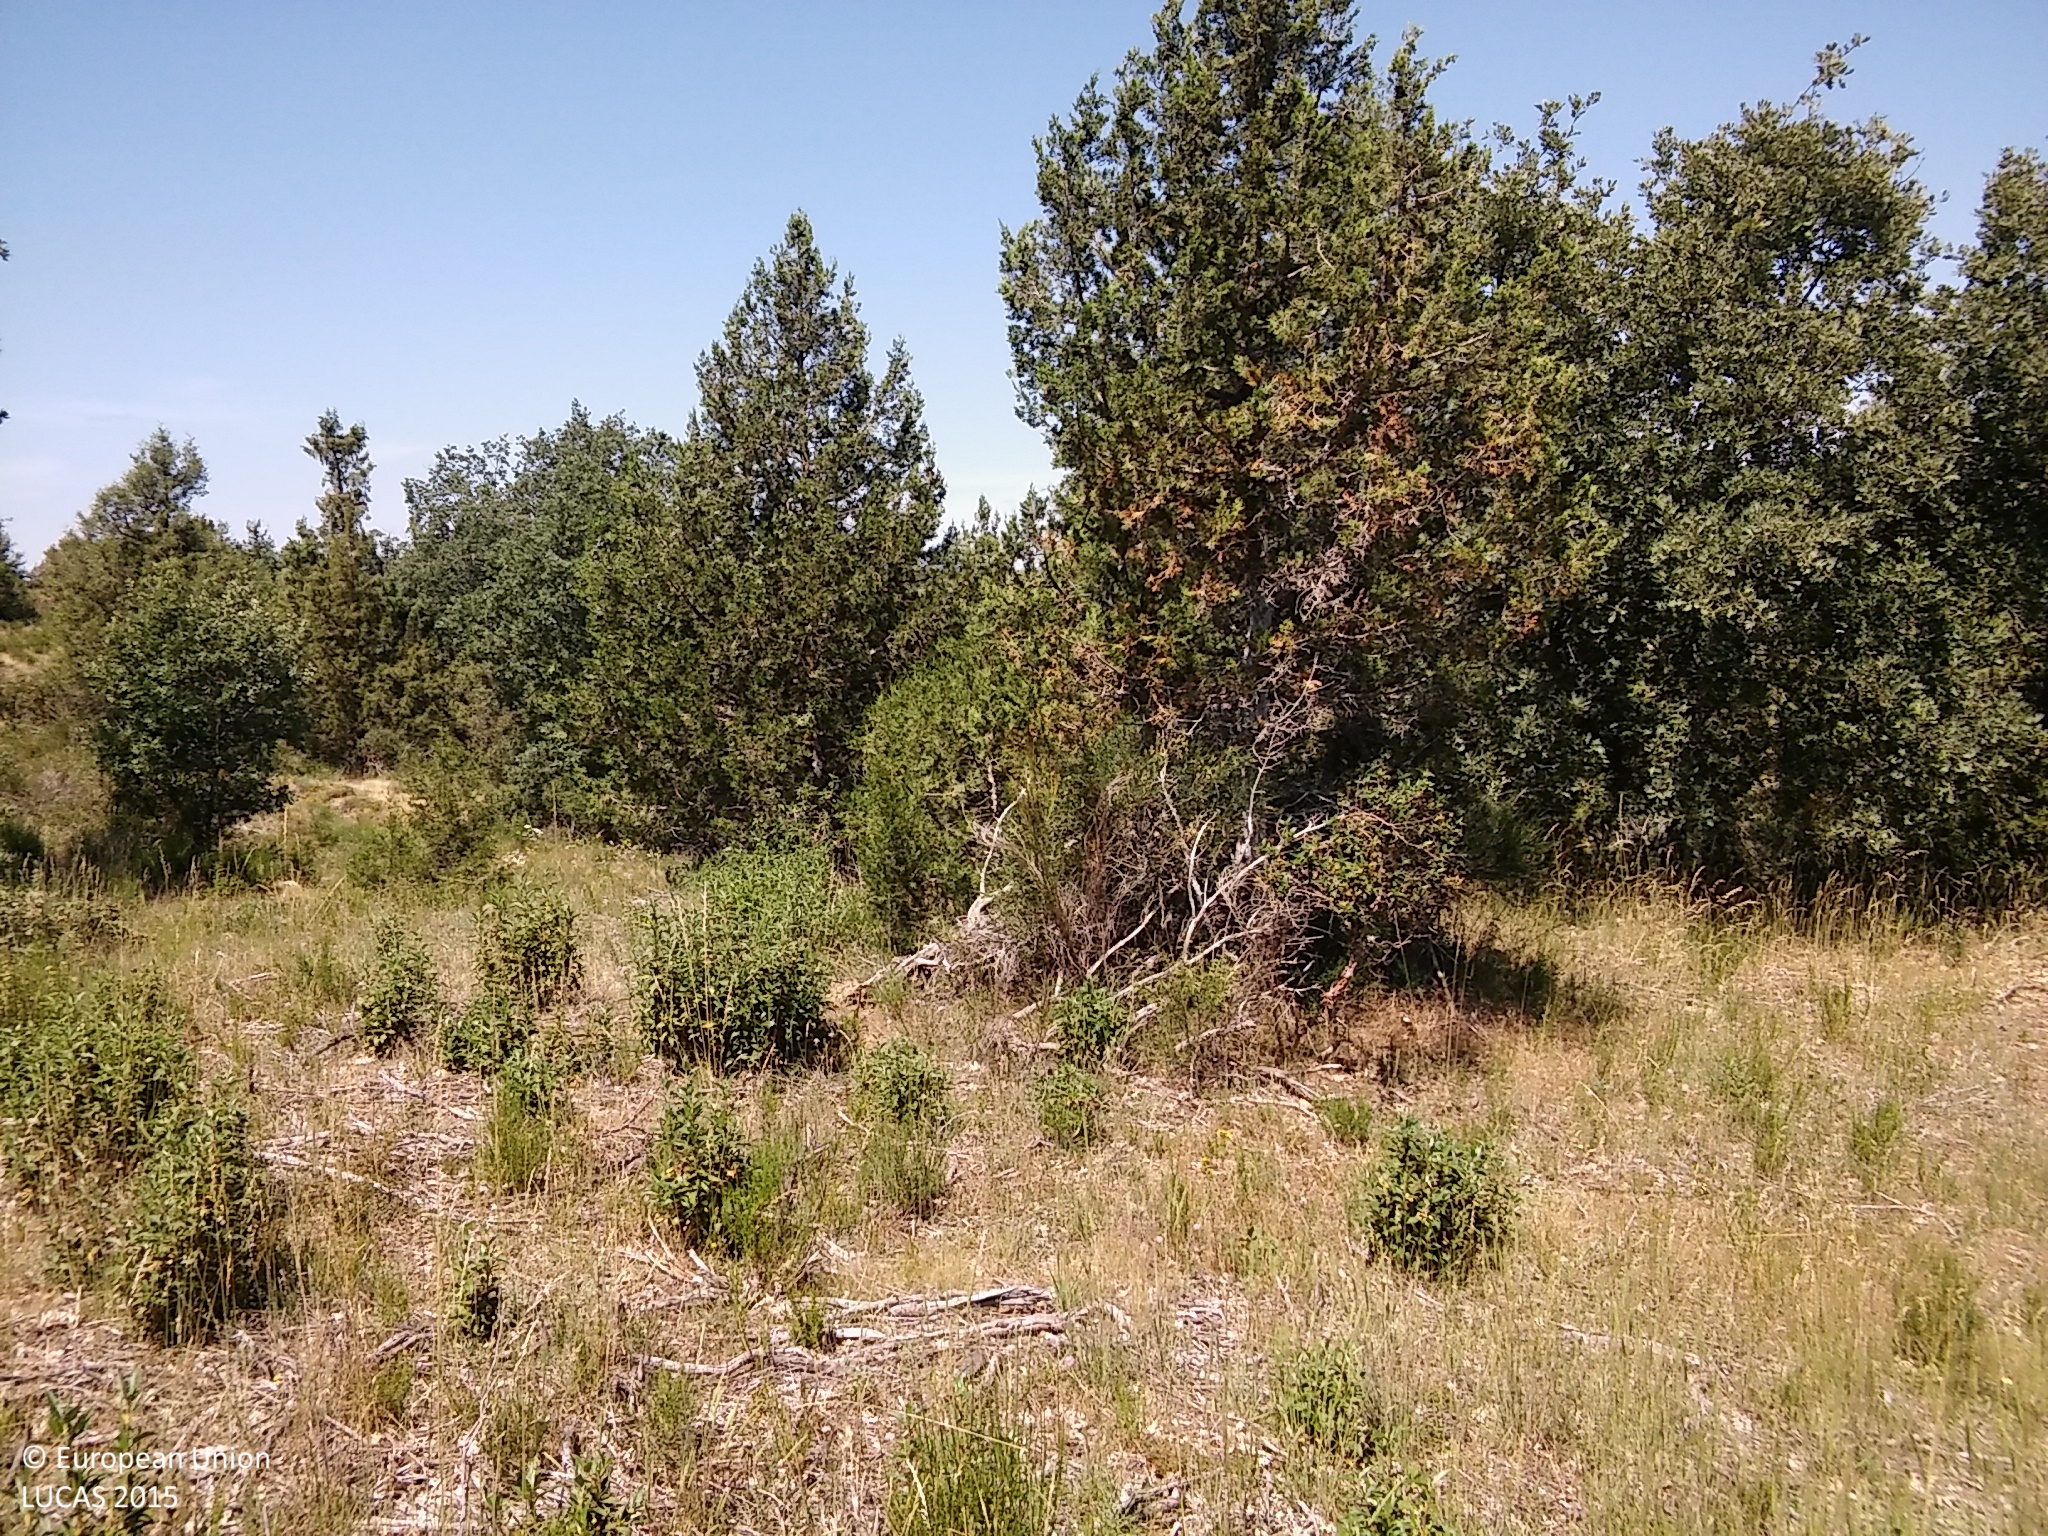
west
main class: Woodland
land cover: Other mixed woodland
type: thermophilous deciduous forest
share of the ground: 50 - 75 %
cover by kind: broadleaved forest trees 35 %, coniferous forest trees 25 %, shrubs 20 %, herbaceous plants 15 %, lichens and mosses 5 %
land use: Forestry
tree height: > 5 m
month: June
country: ES
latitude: 41.1878
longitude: -3.6983
